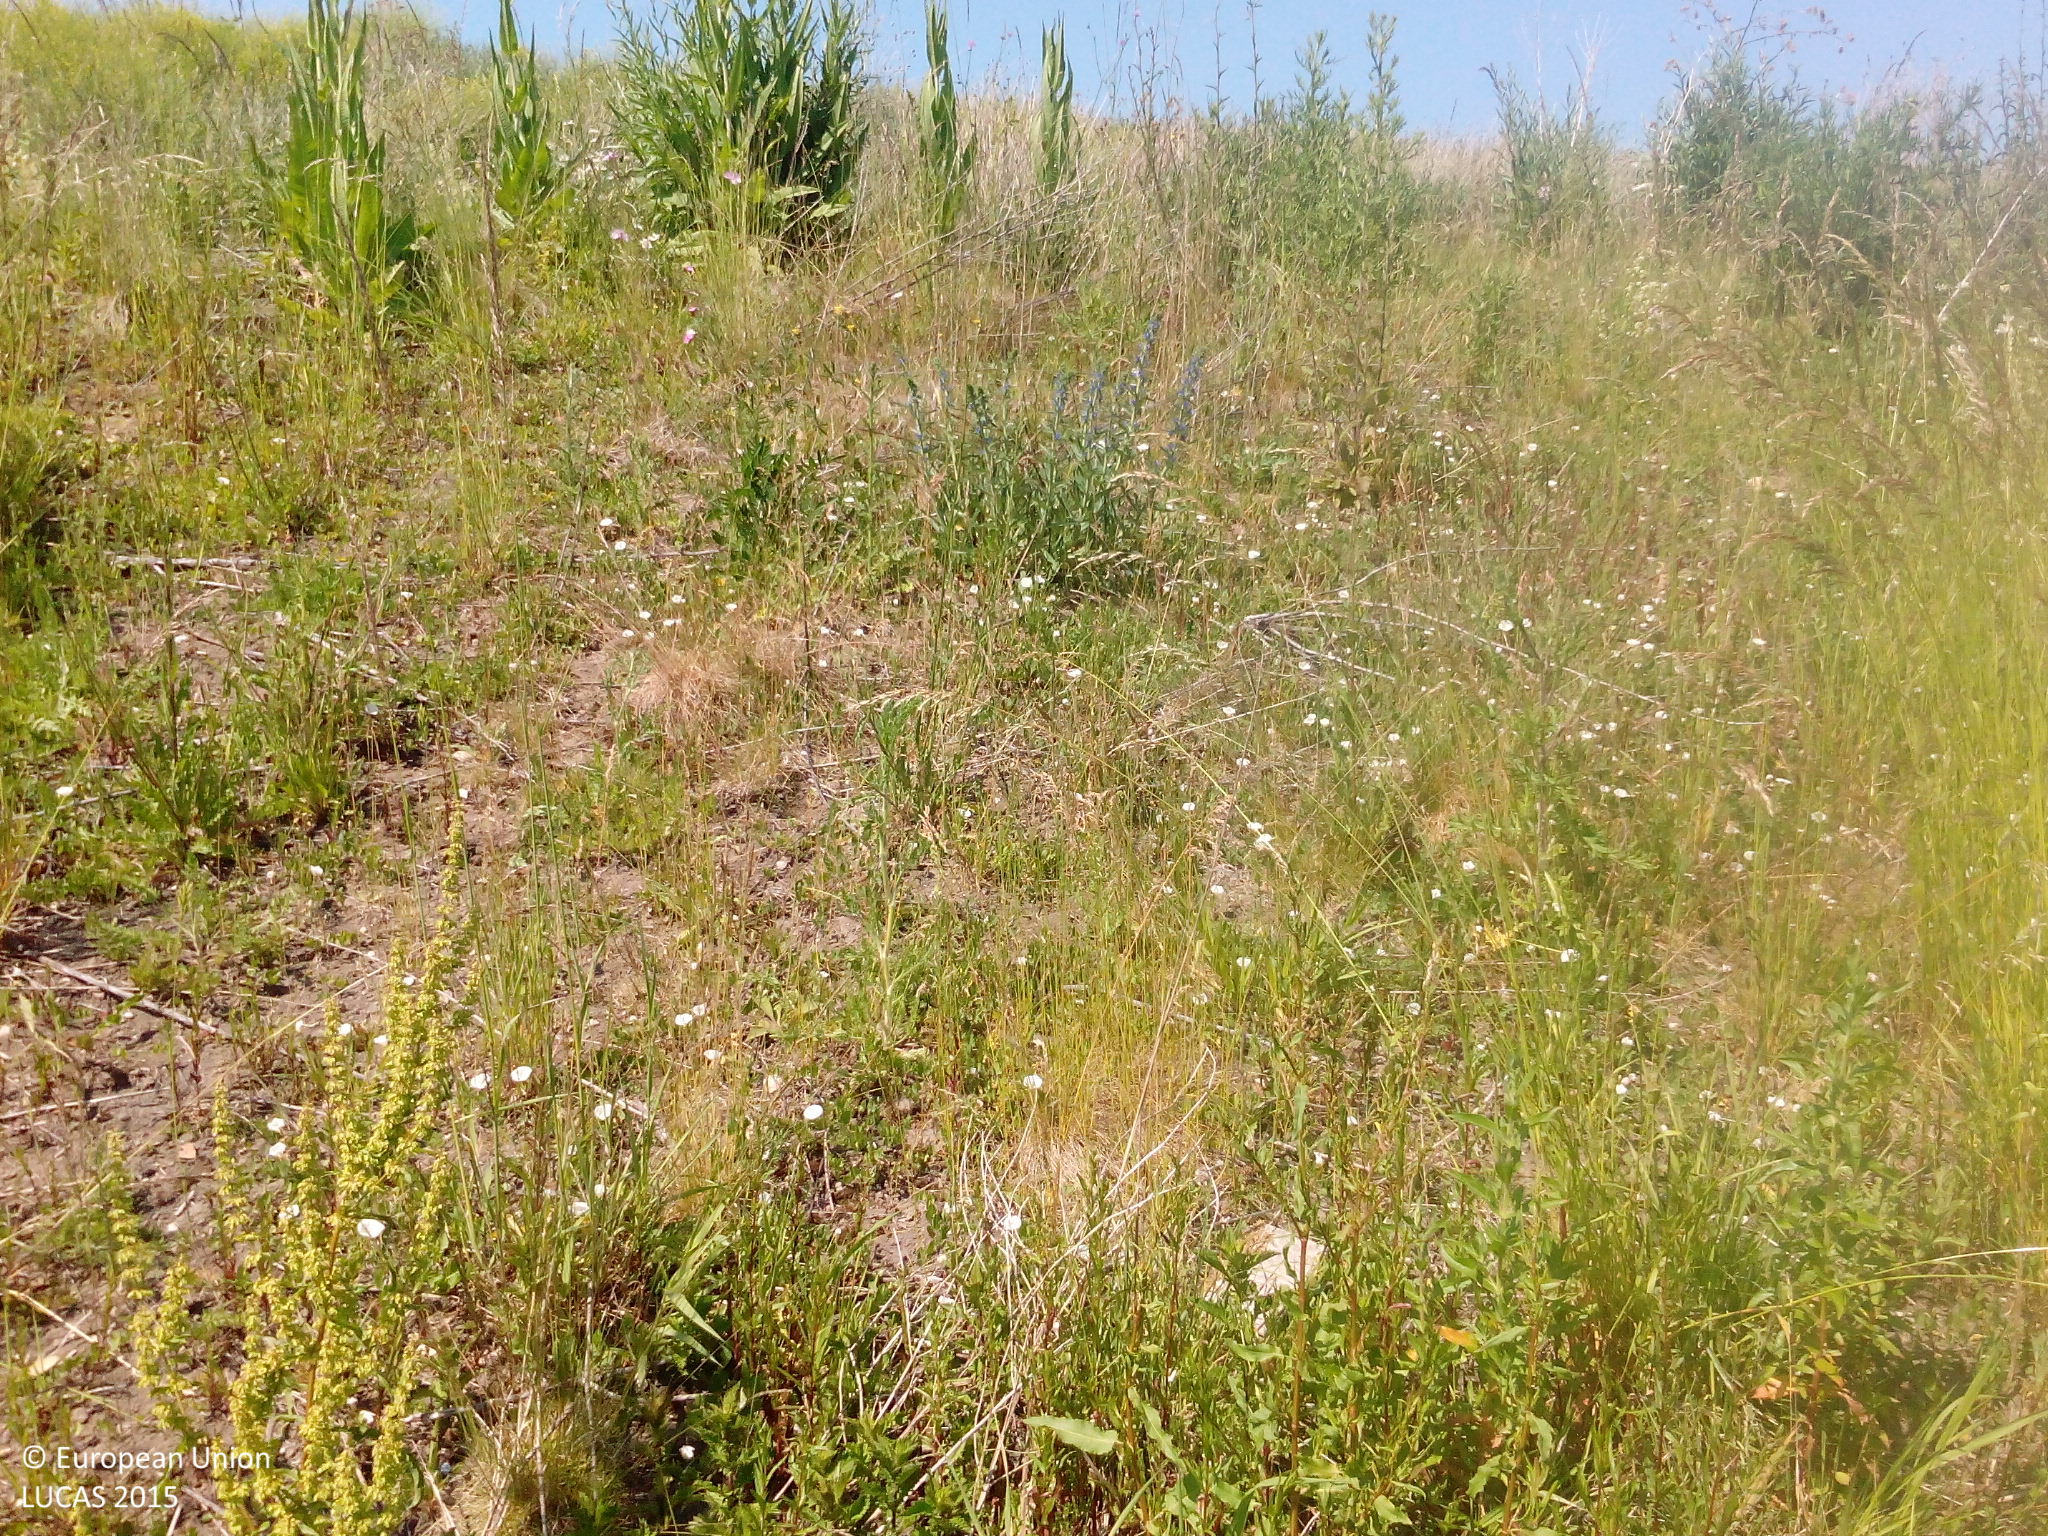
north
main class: Woodland
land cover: Broadleaved woodland
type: floodplain forest
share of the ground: 50 - 75 %
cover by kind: broadleaved forest trees 50 %, herbaceous plants 30 %, shrubs 20 %
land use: Semi-natural and natural areas not in use
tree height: < 5 m
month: June
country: DE
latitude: 49.7556
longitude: 8.1543
